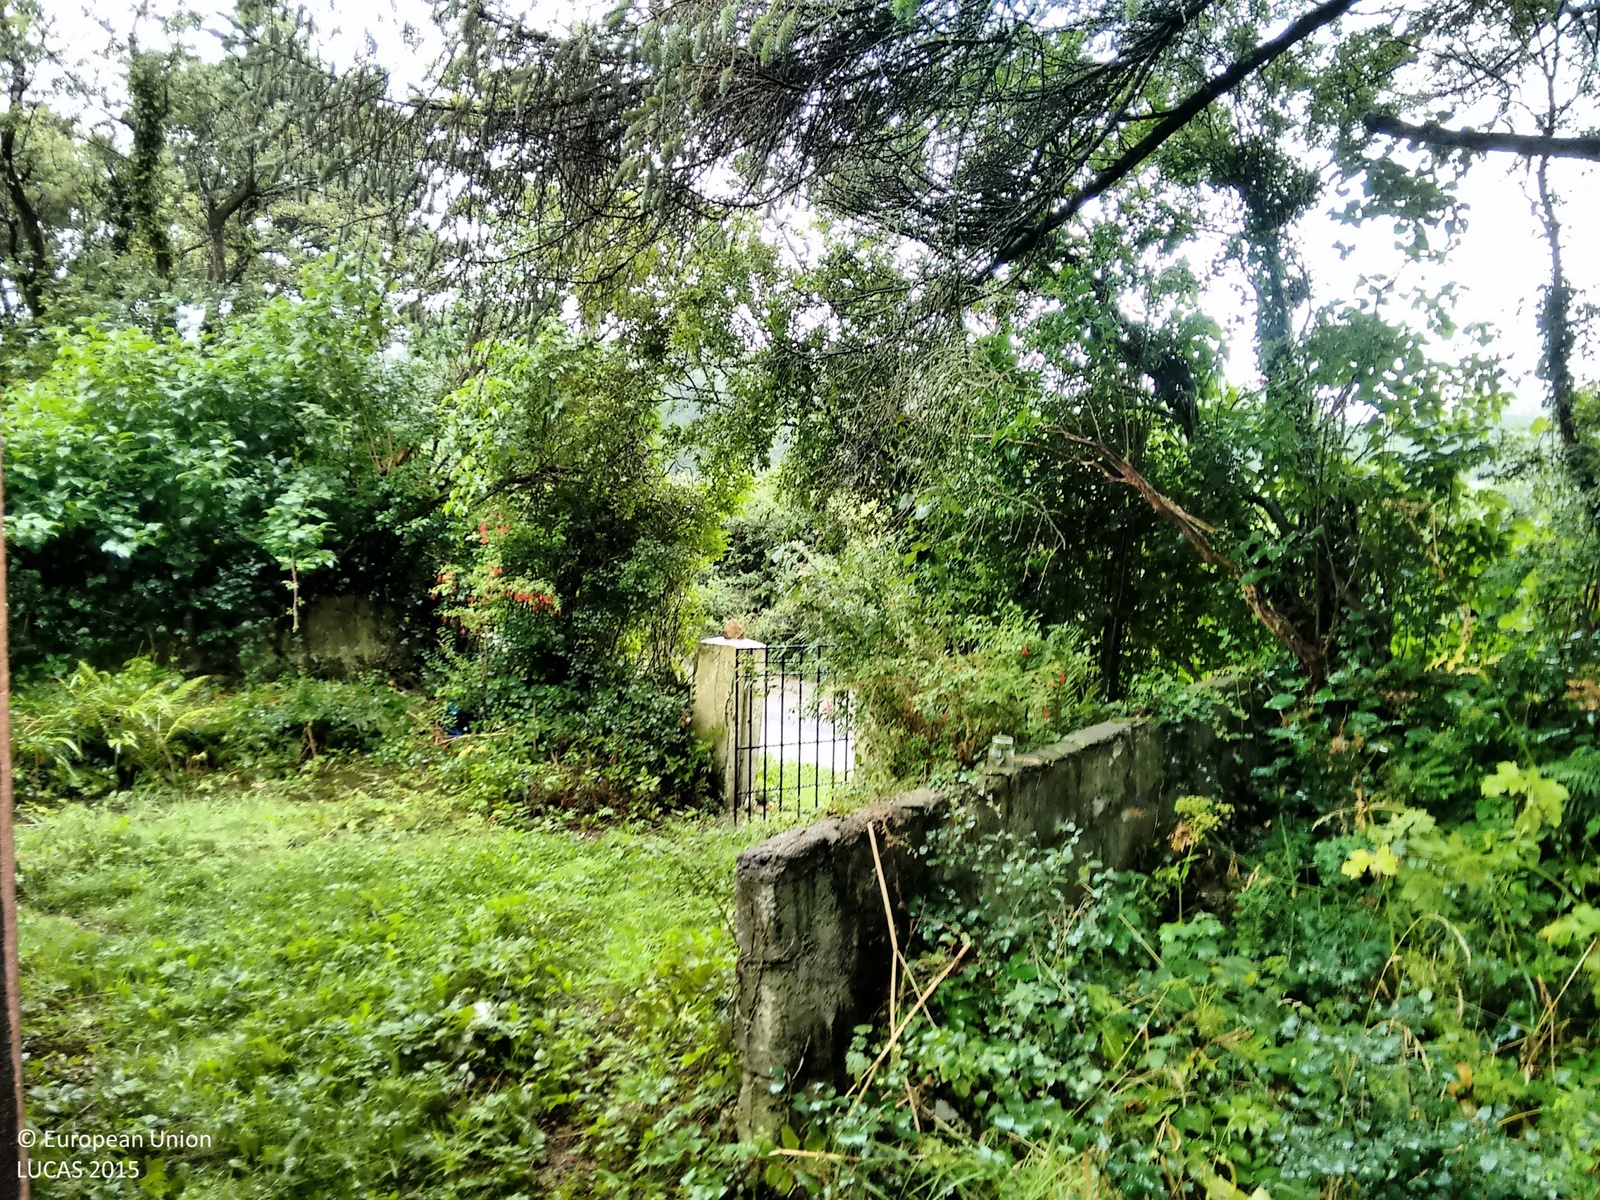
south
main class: Woodland
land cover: Broadleaved woodland
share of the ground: > 75 %
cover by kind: broadleaved forest trees 95 %, herbaceous plants 5 %
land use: Residential
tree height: > 5 m
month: August
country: IE
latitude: 52.4836
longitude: -6.3356
